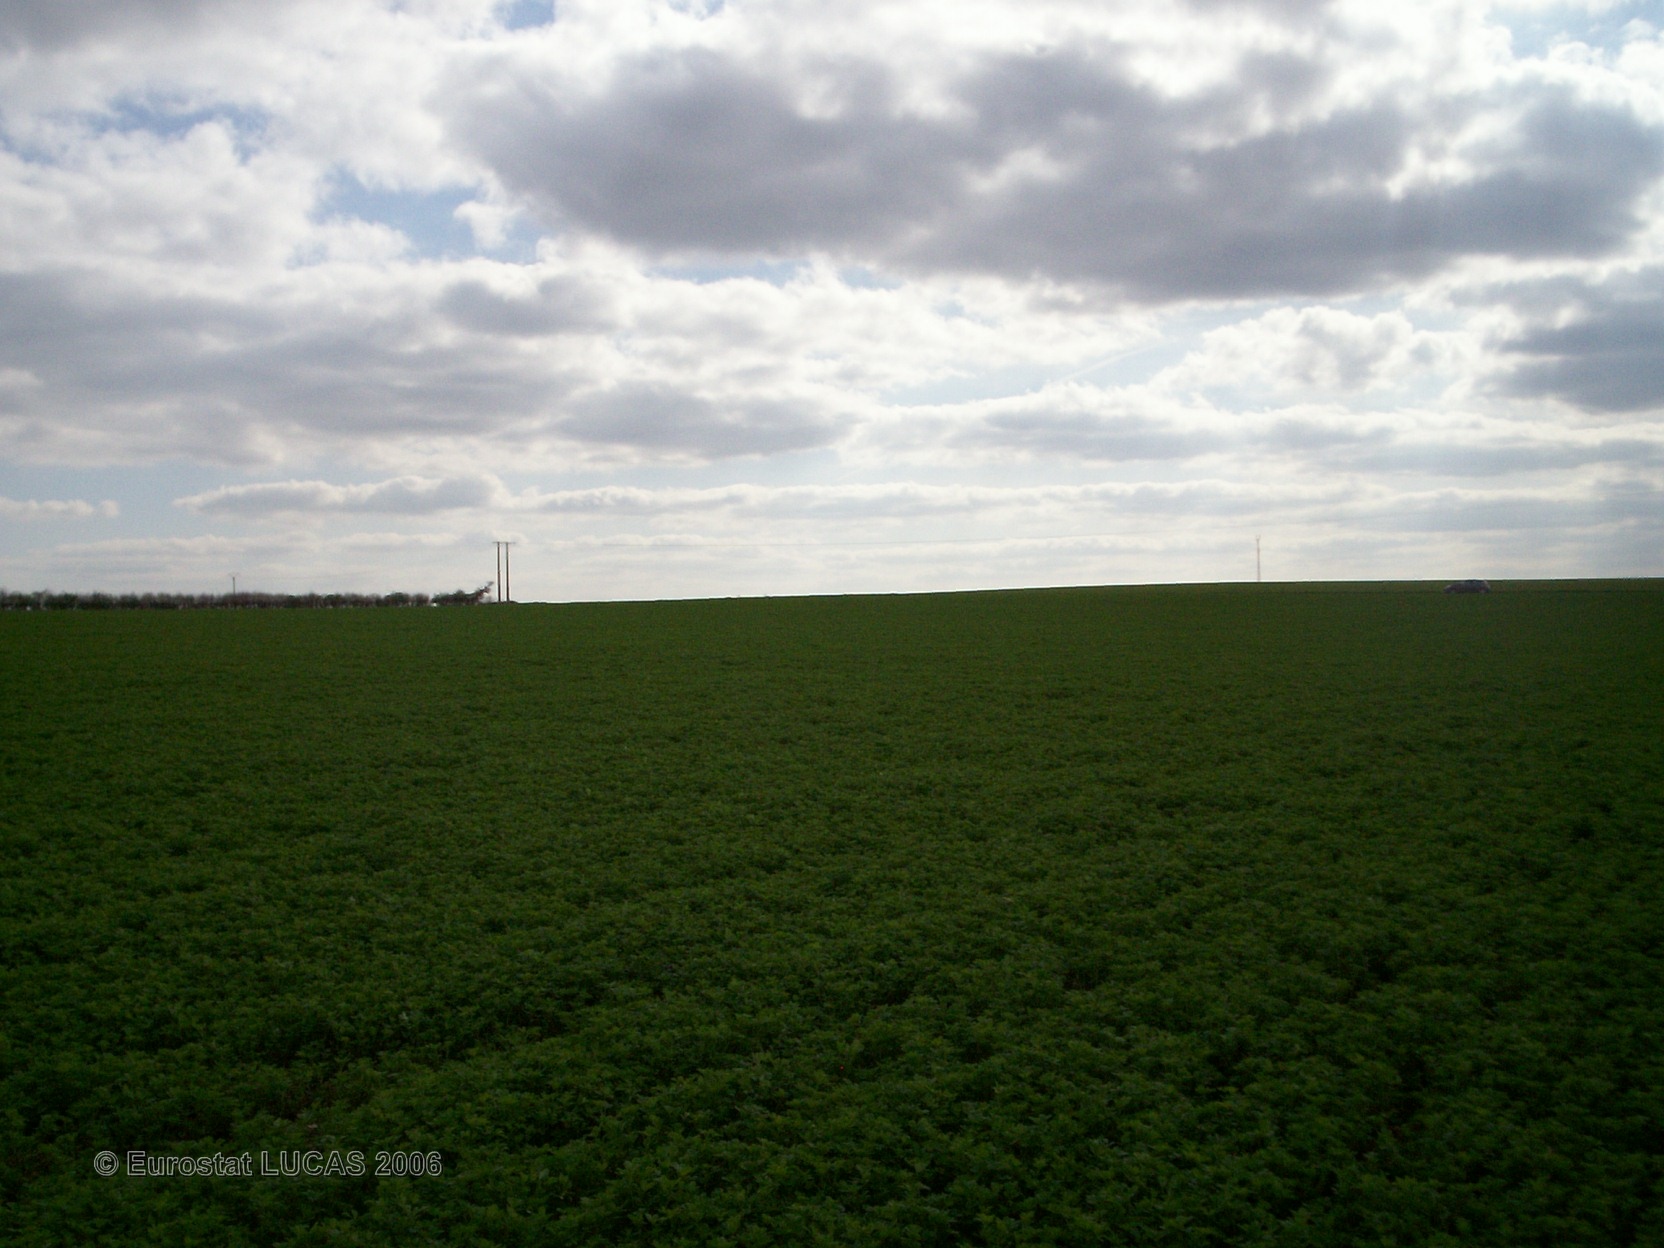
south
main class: Cropland
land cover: Lucerne
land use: Agriculture (excluding fallow land and kitchen gardens)
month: April
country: FR
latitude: 48.4474
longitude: 2.9208
